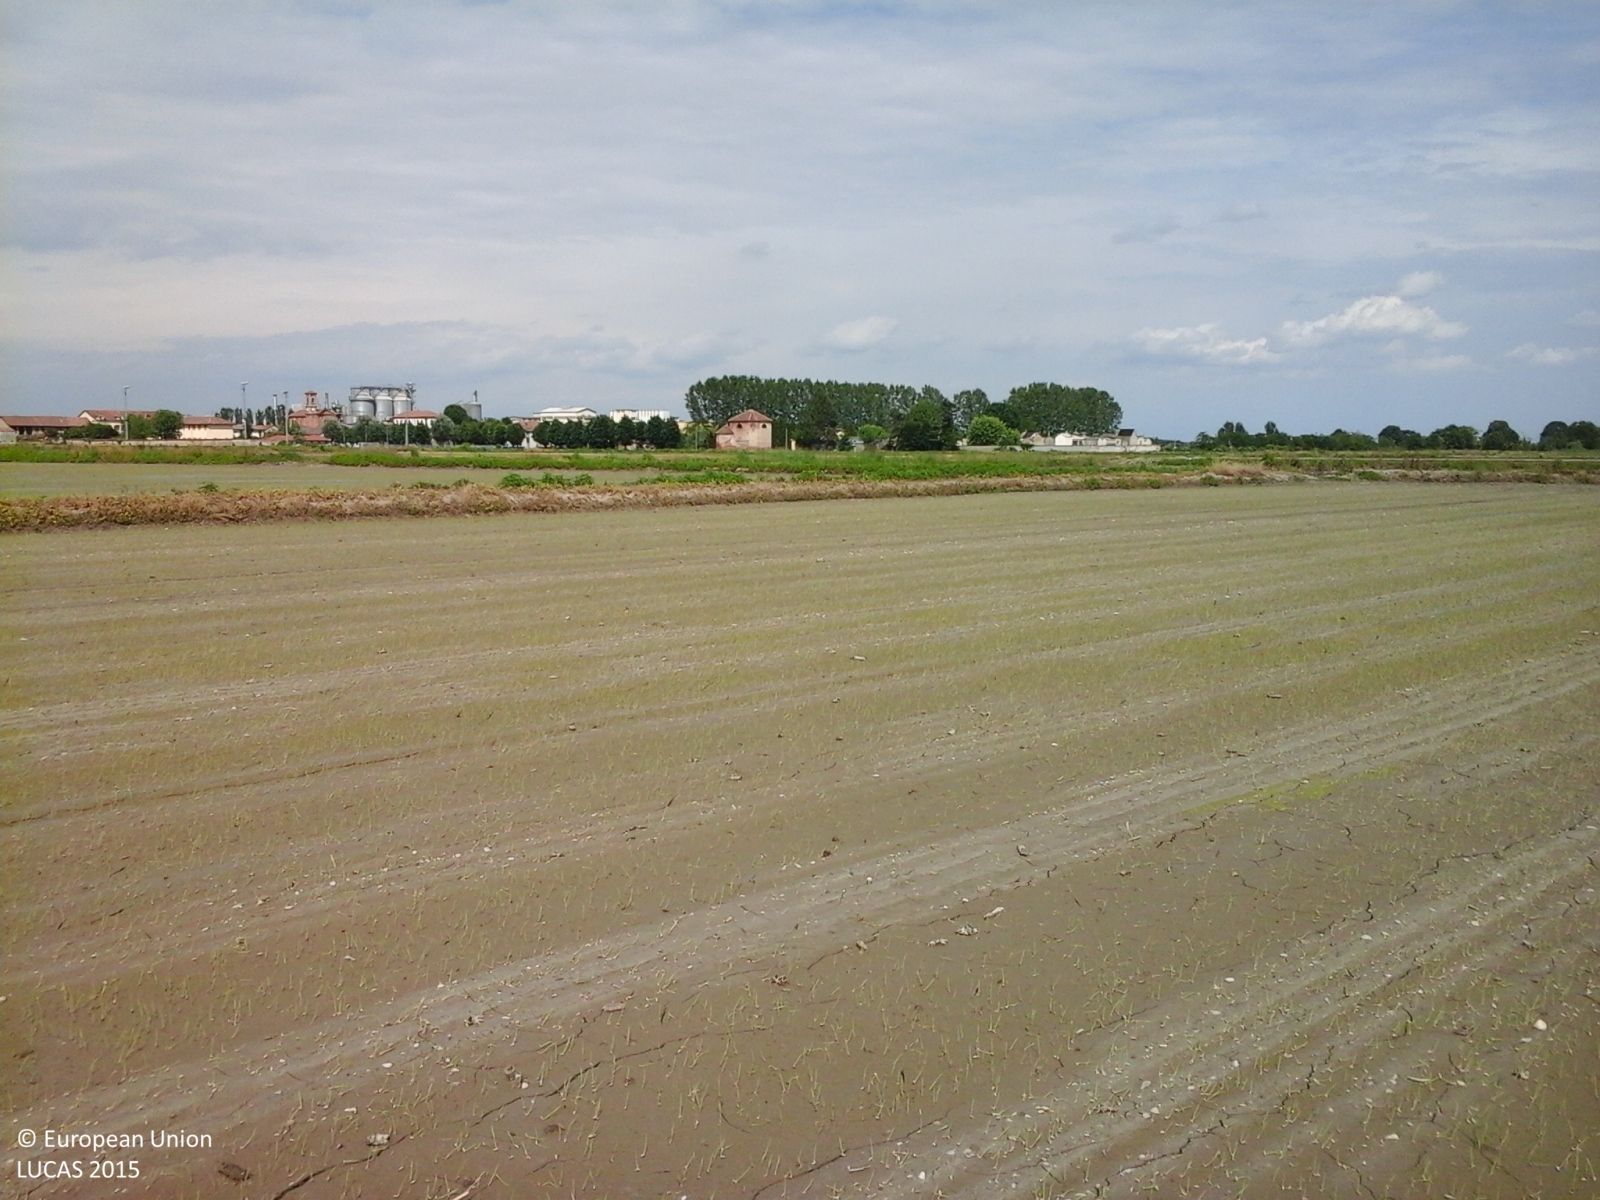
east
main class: Cropland
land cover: Rice
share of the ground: < 10 %
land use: Agriculture (excluding fallow land and kitchen gardens)
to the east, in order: Rice; Grass margins; Ditches and canals; Grass margins; Rice; Other structural elements; Rice; Grass margins; Rice; Grass margins; Rice; Grass margins; Ditches and canals; Grass margins; Rice
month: May
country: IT
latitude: 45.3269
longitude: 8.2041
